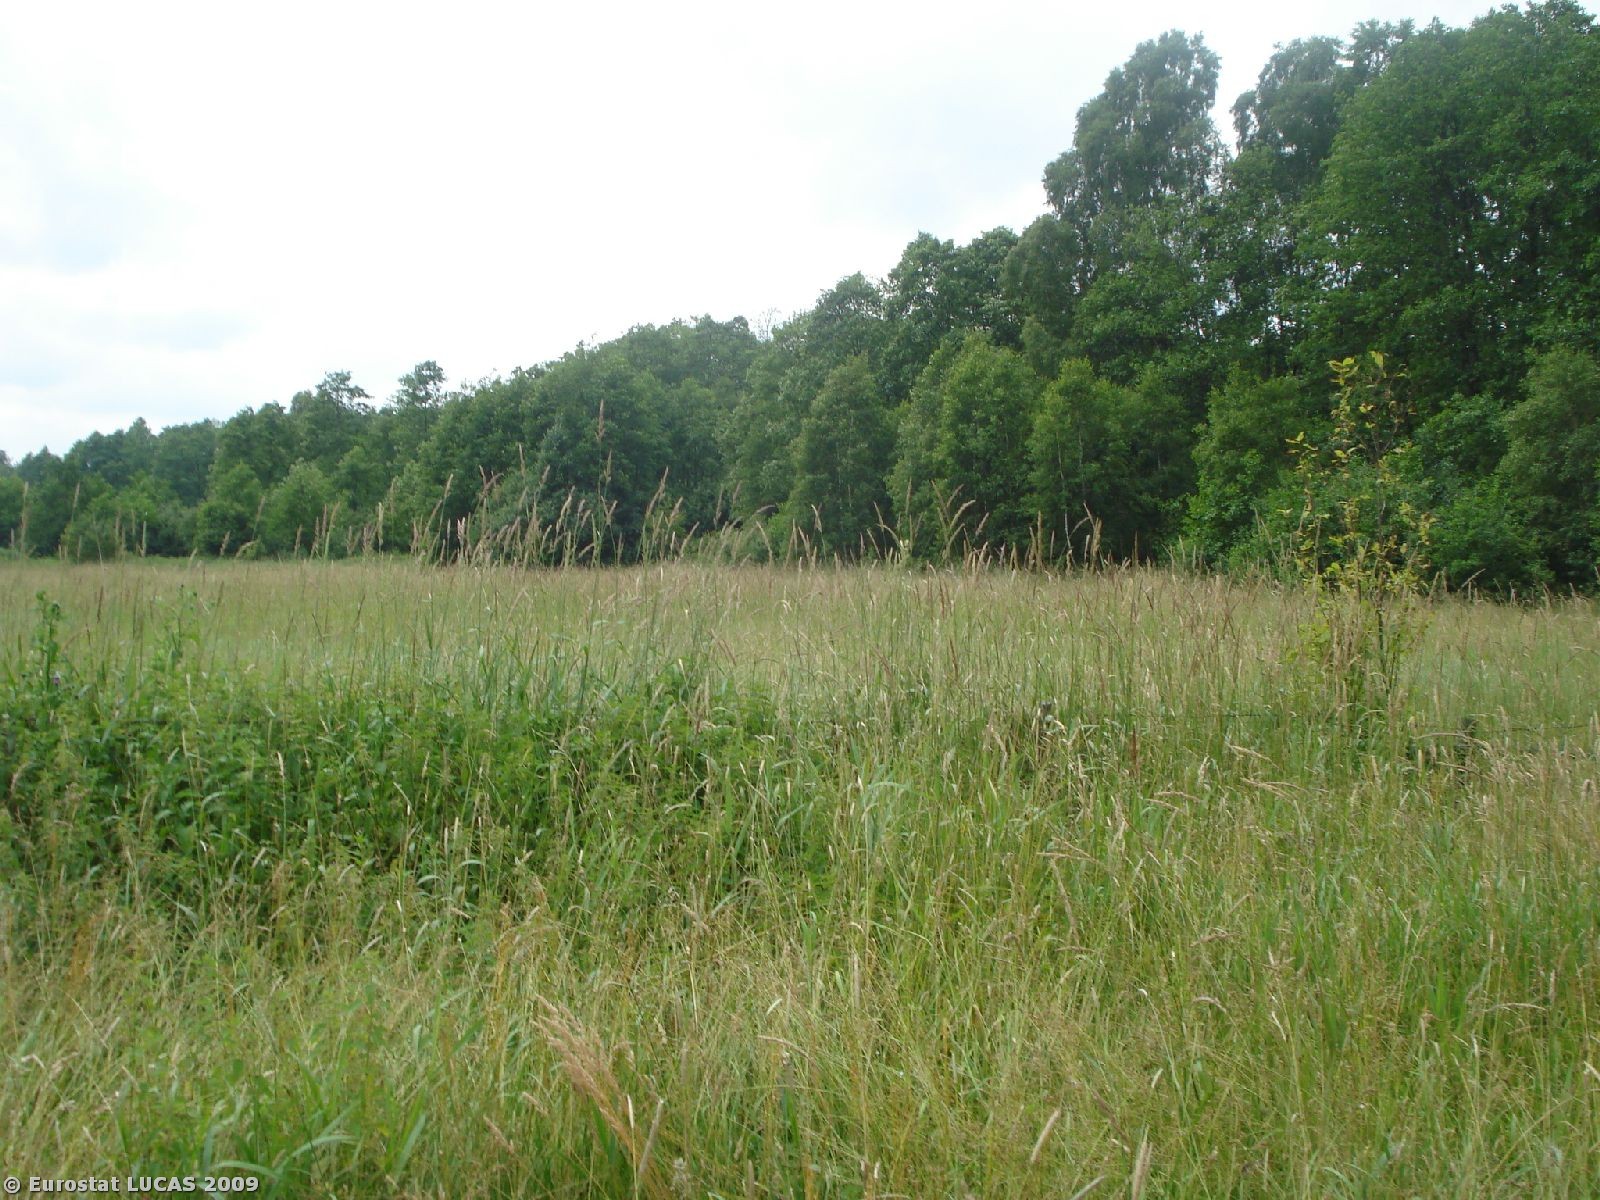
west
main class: Grassland
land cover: Grassland with sparse tree/shrub cover
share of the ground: > 75 %
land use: Agriculture (excluding fallow land and kitchen gardens)
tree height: > 5 m
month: July
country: PL
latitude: 52.6226
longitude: 23.1810
